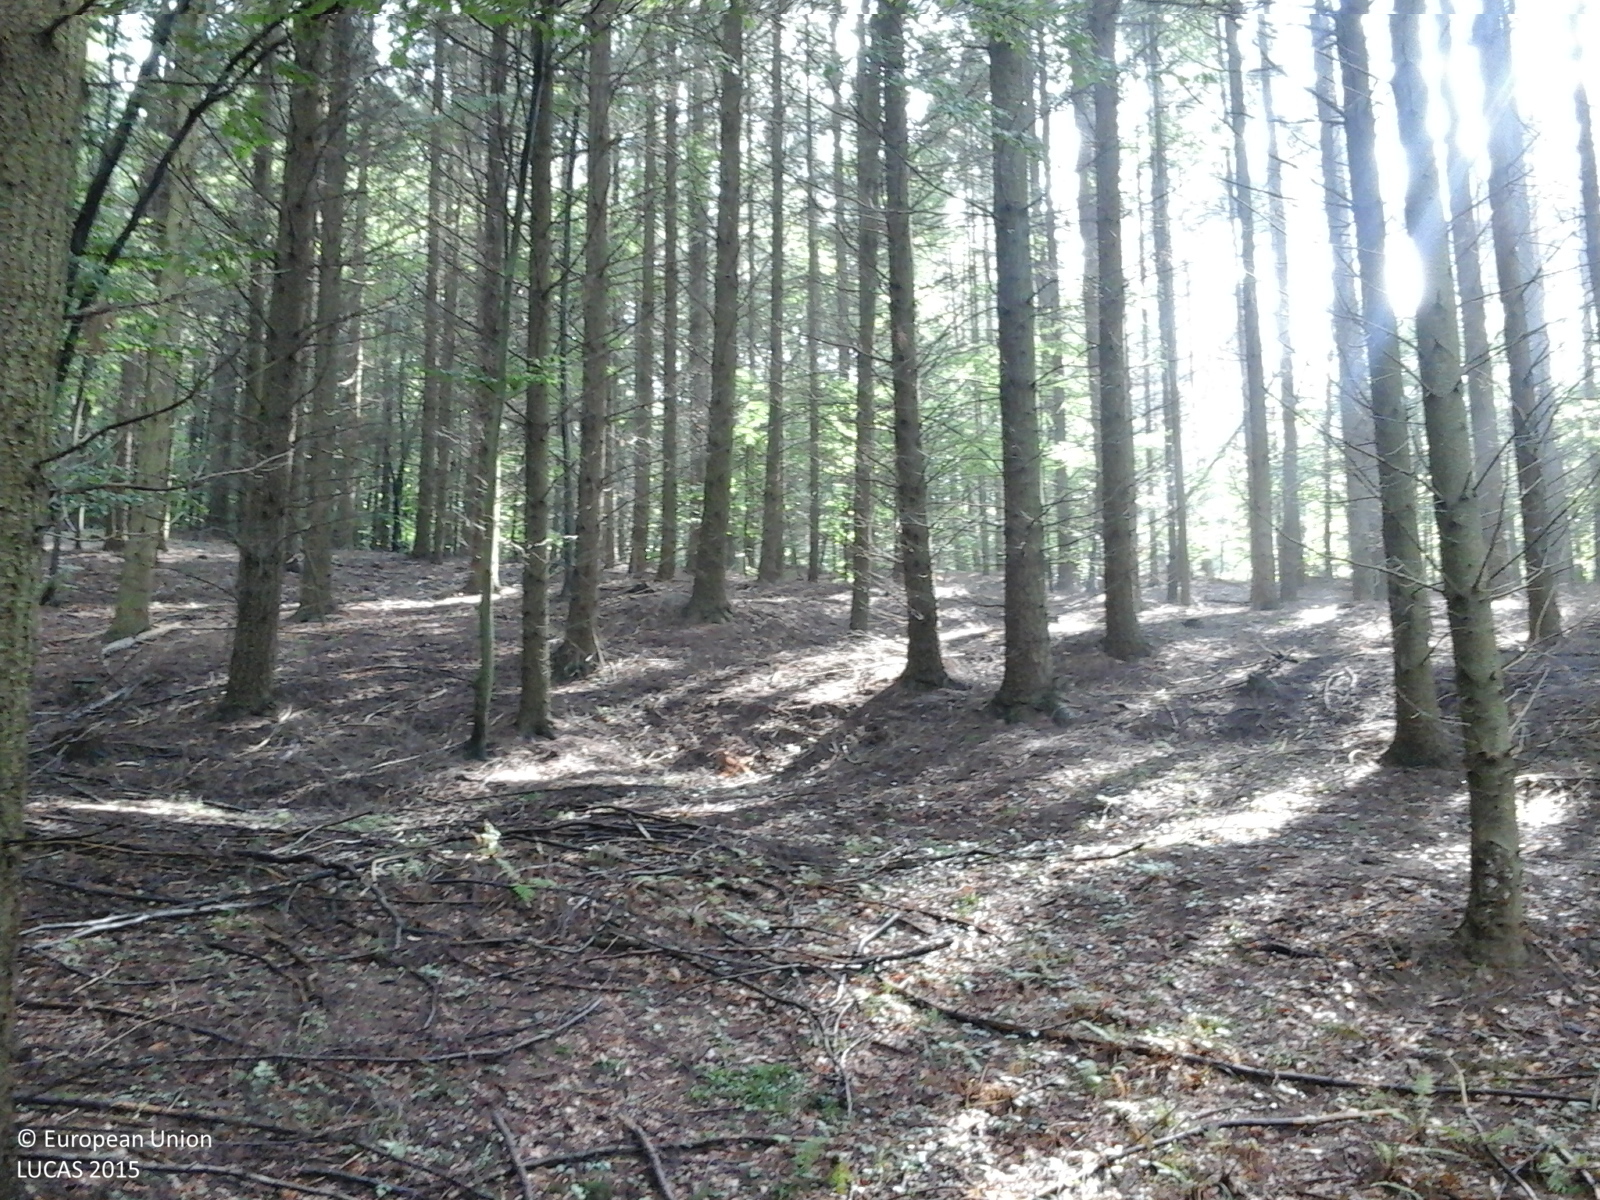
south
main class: Woodland
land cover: Pine dominated mixed woodland
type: alpine coniferous forest
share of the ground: > 75 %
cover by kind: coniferous forest trees 75 %, broadleaved forest trees 25 %
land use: Forestry
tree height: > 5 m
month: September
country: RO
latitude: 46.9443
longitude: 22.6552
